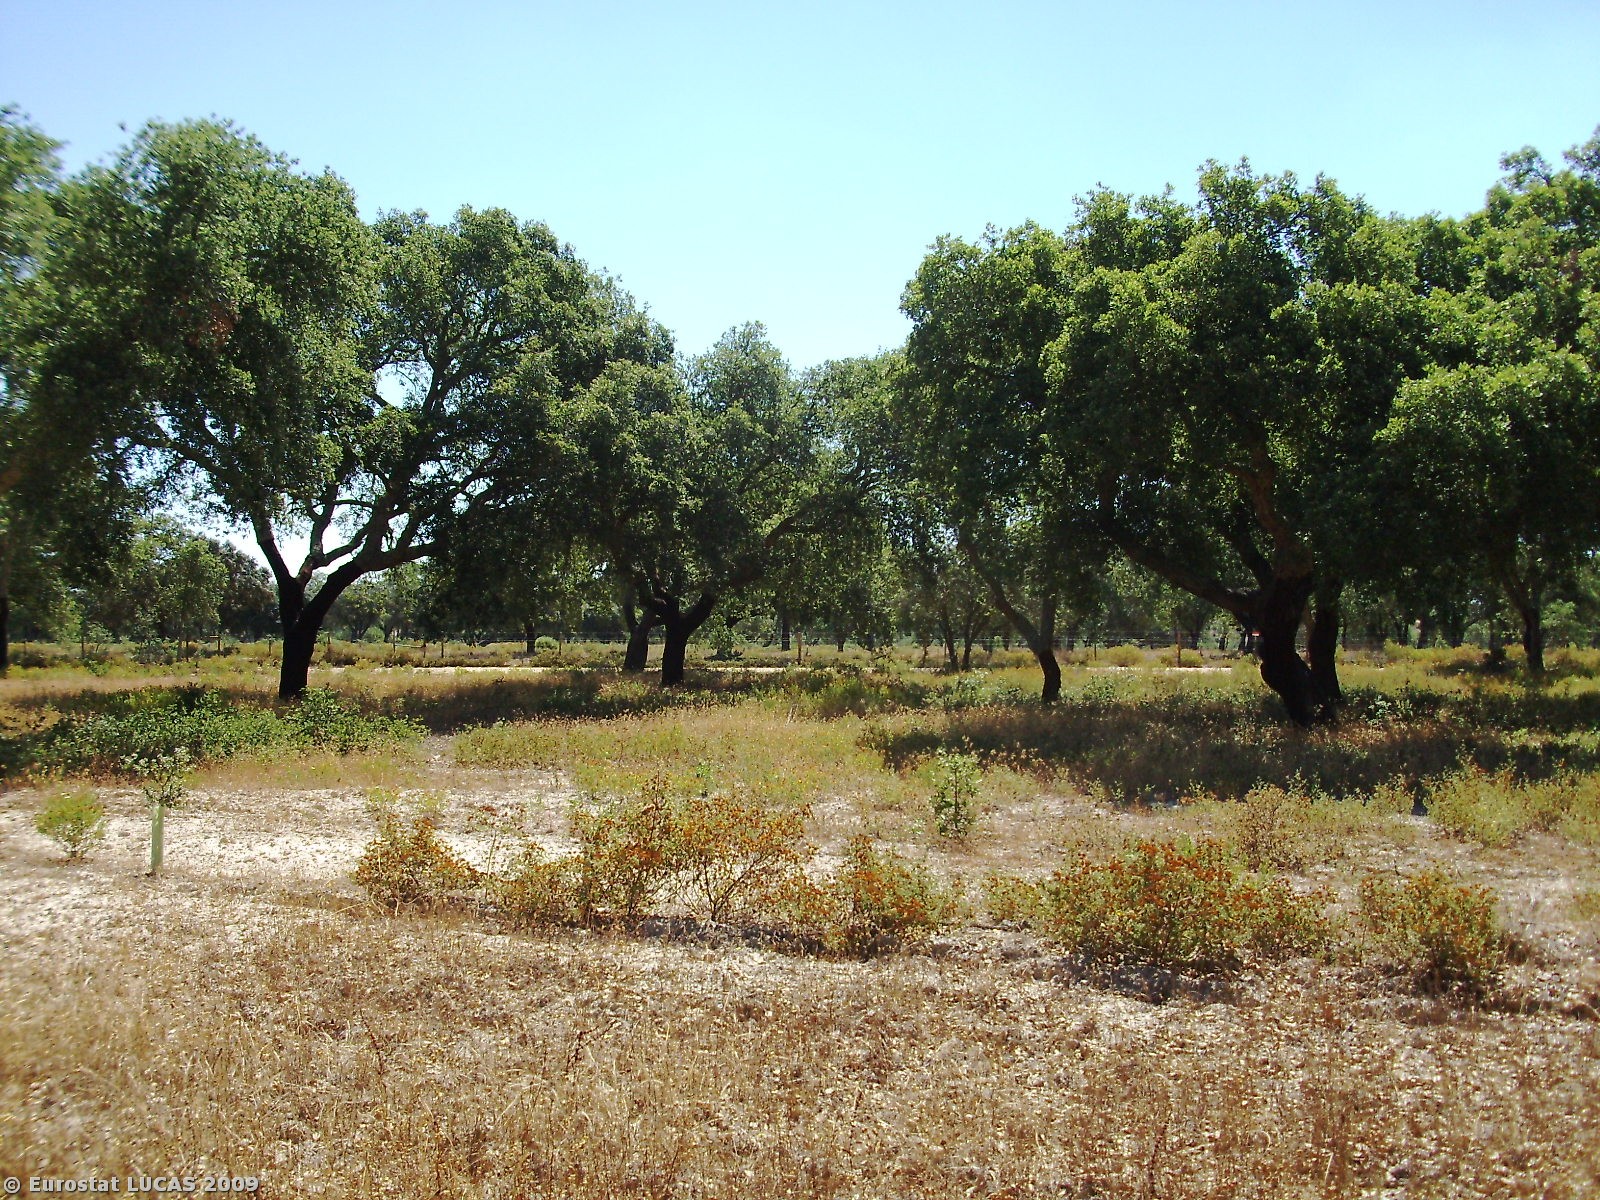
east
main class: Woodland
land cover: Broadleaved woodland
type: broadleaved evergreen forest
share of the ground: 25 - 50 %
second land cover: Spontaneously vegetated surfaces
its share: 25 - 50 %
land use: Forestry
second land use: Fallow land
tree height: > 5 m
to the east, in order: Broadleaved woodland; Spontaneously vegetated surfaces; Broadleaved woodland; Shrubland with sparse tree cover; Fences; Broadleaved woodland
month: July
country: PT
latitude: 37.7886
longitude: -8.3977
